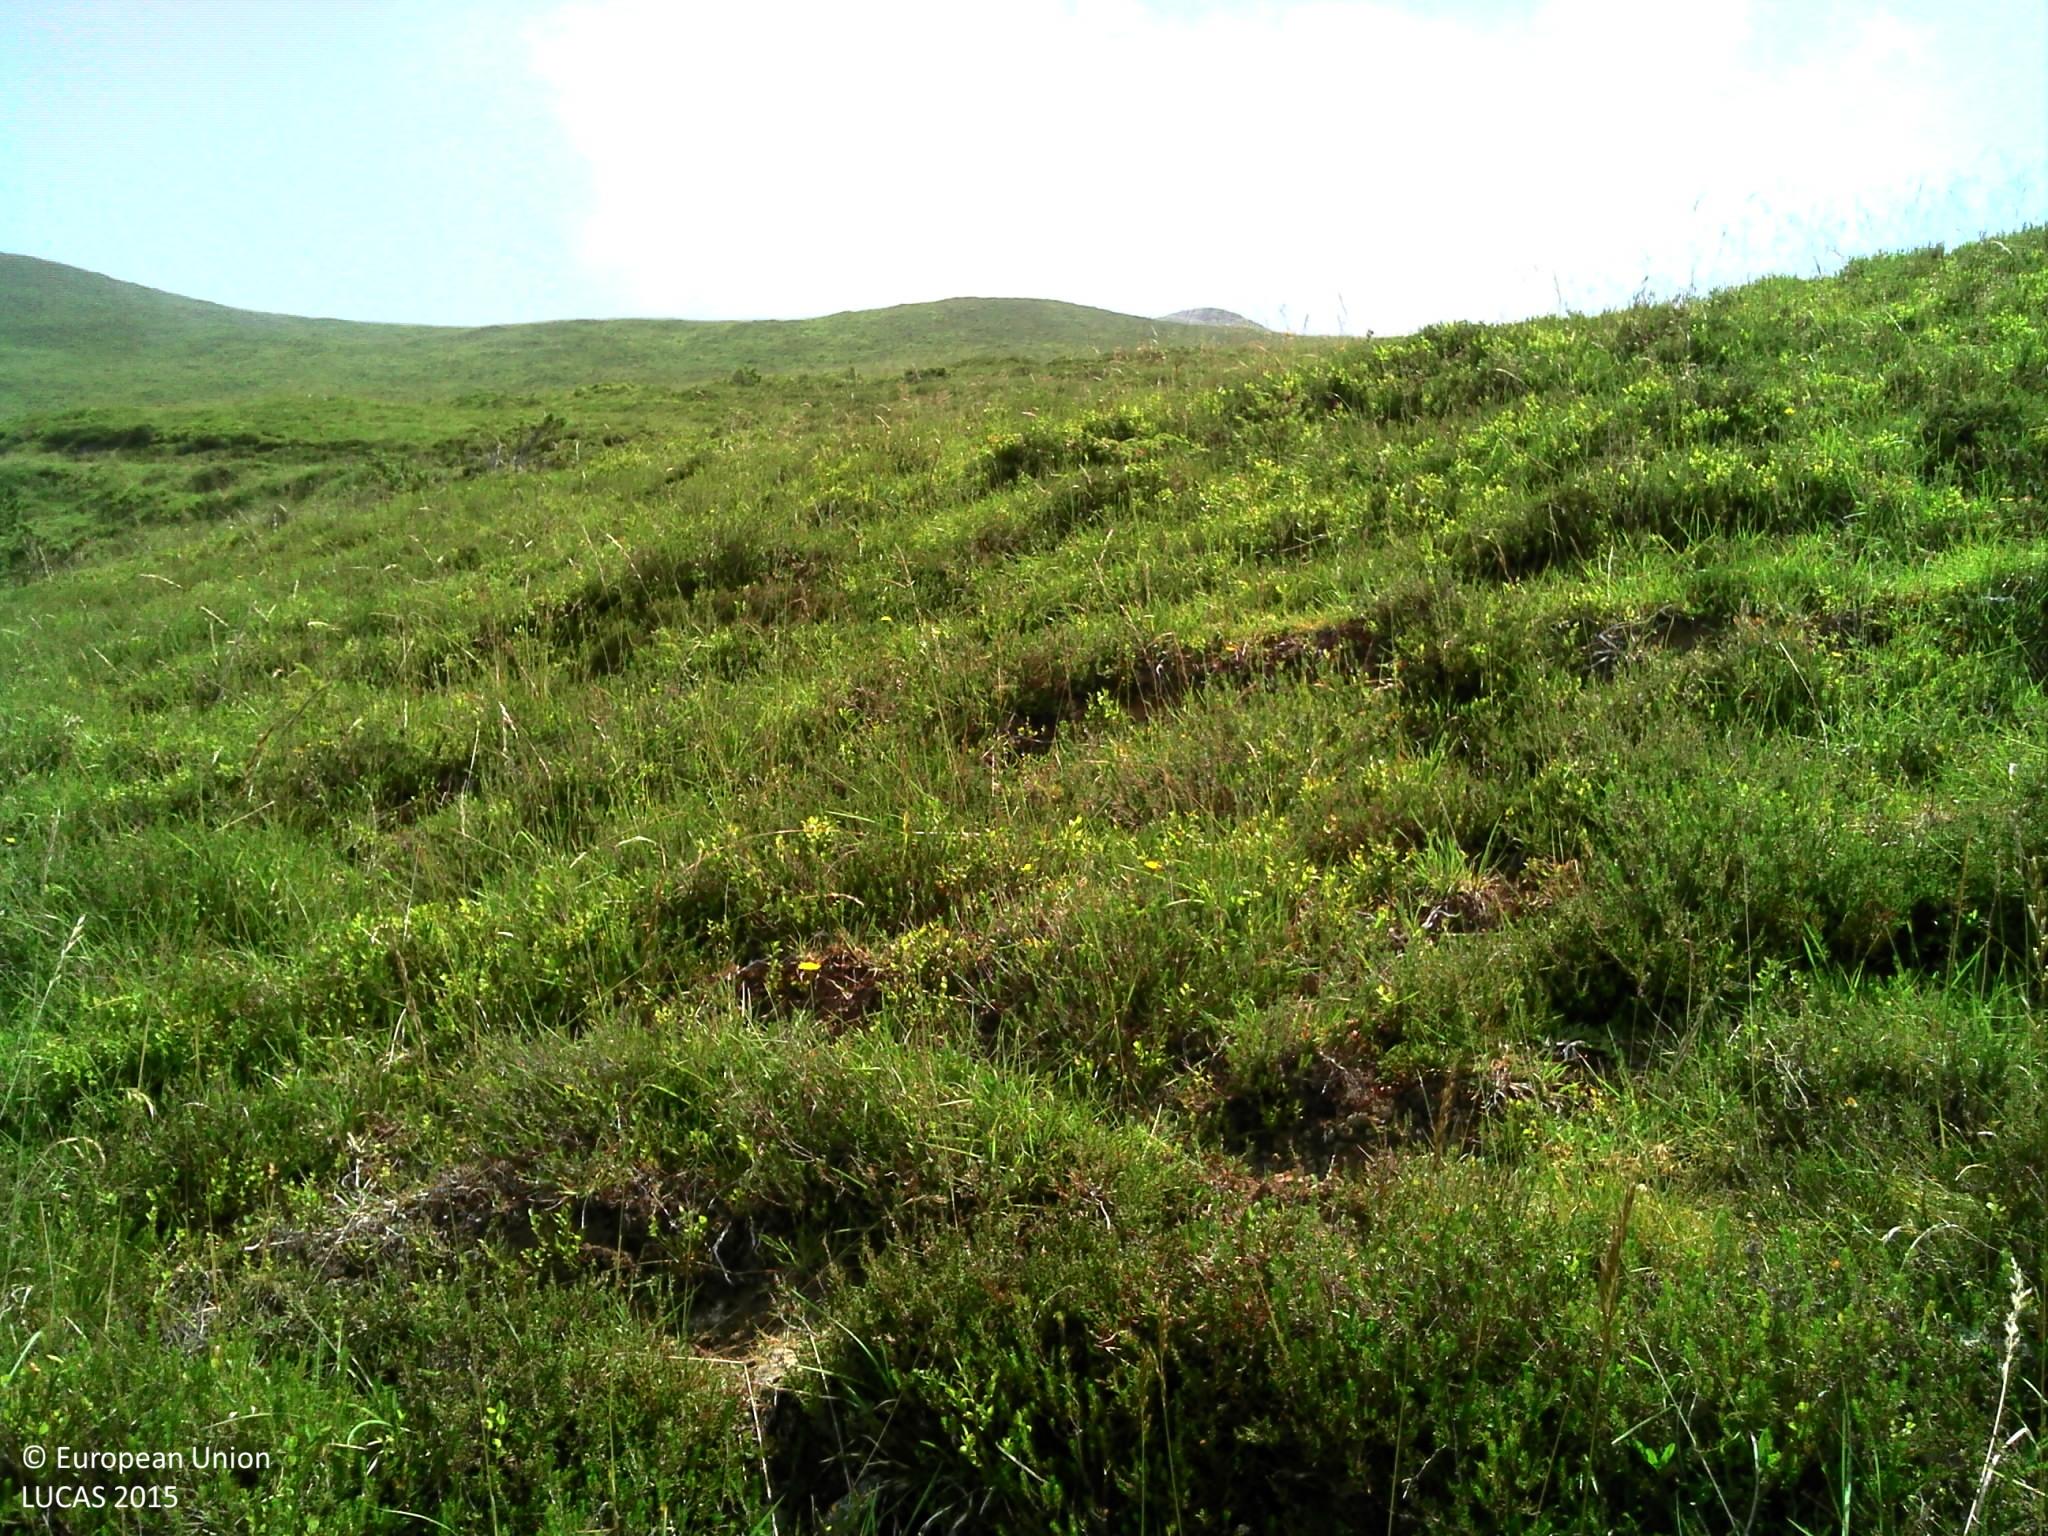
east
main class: Shrubland
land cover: Shrubland without tree cover
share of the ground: > 75 %
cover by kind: shrubs 60 %, herbaceous plants 40 %
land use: Agriculture (excluding fallow land and kitchen gardens)
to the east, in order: Shrubland without tree cover; Grass margins; Tracks; Grassland without tree/shrub cover; Shrubland without tree cover; Grassland without tree/shrub cover
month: July
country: FR
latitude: 42.9677
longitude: -0.2655
